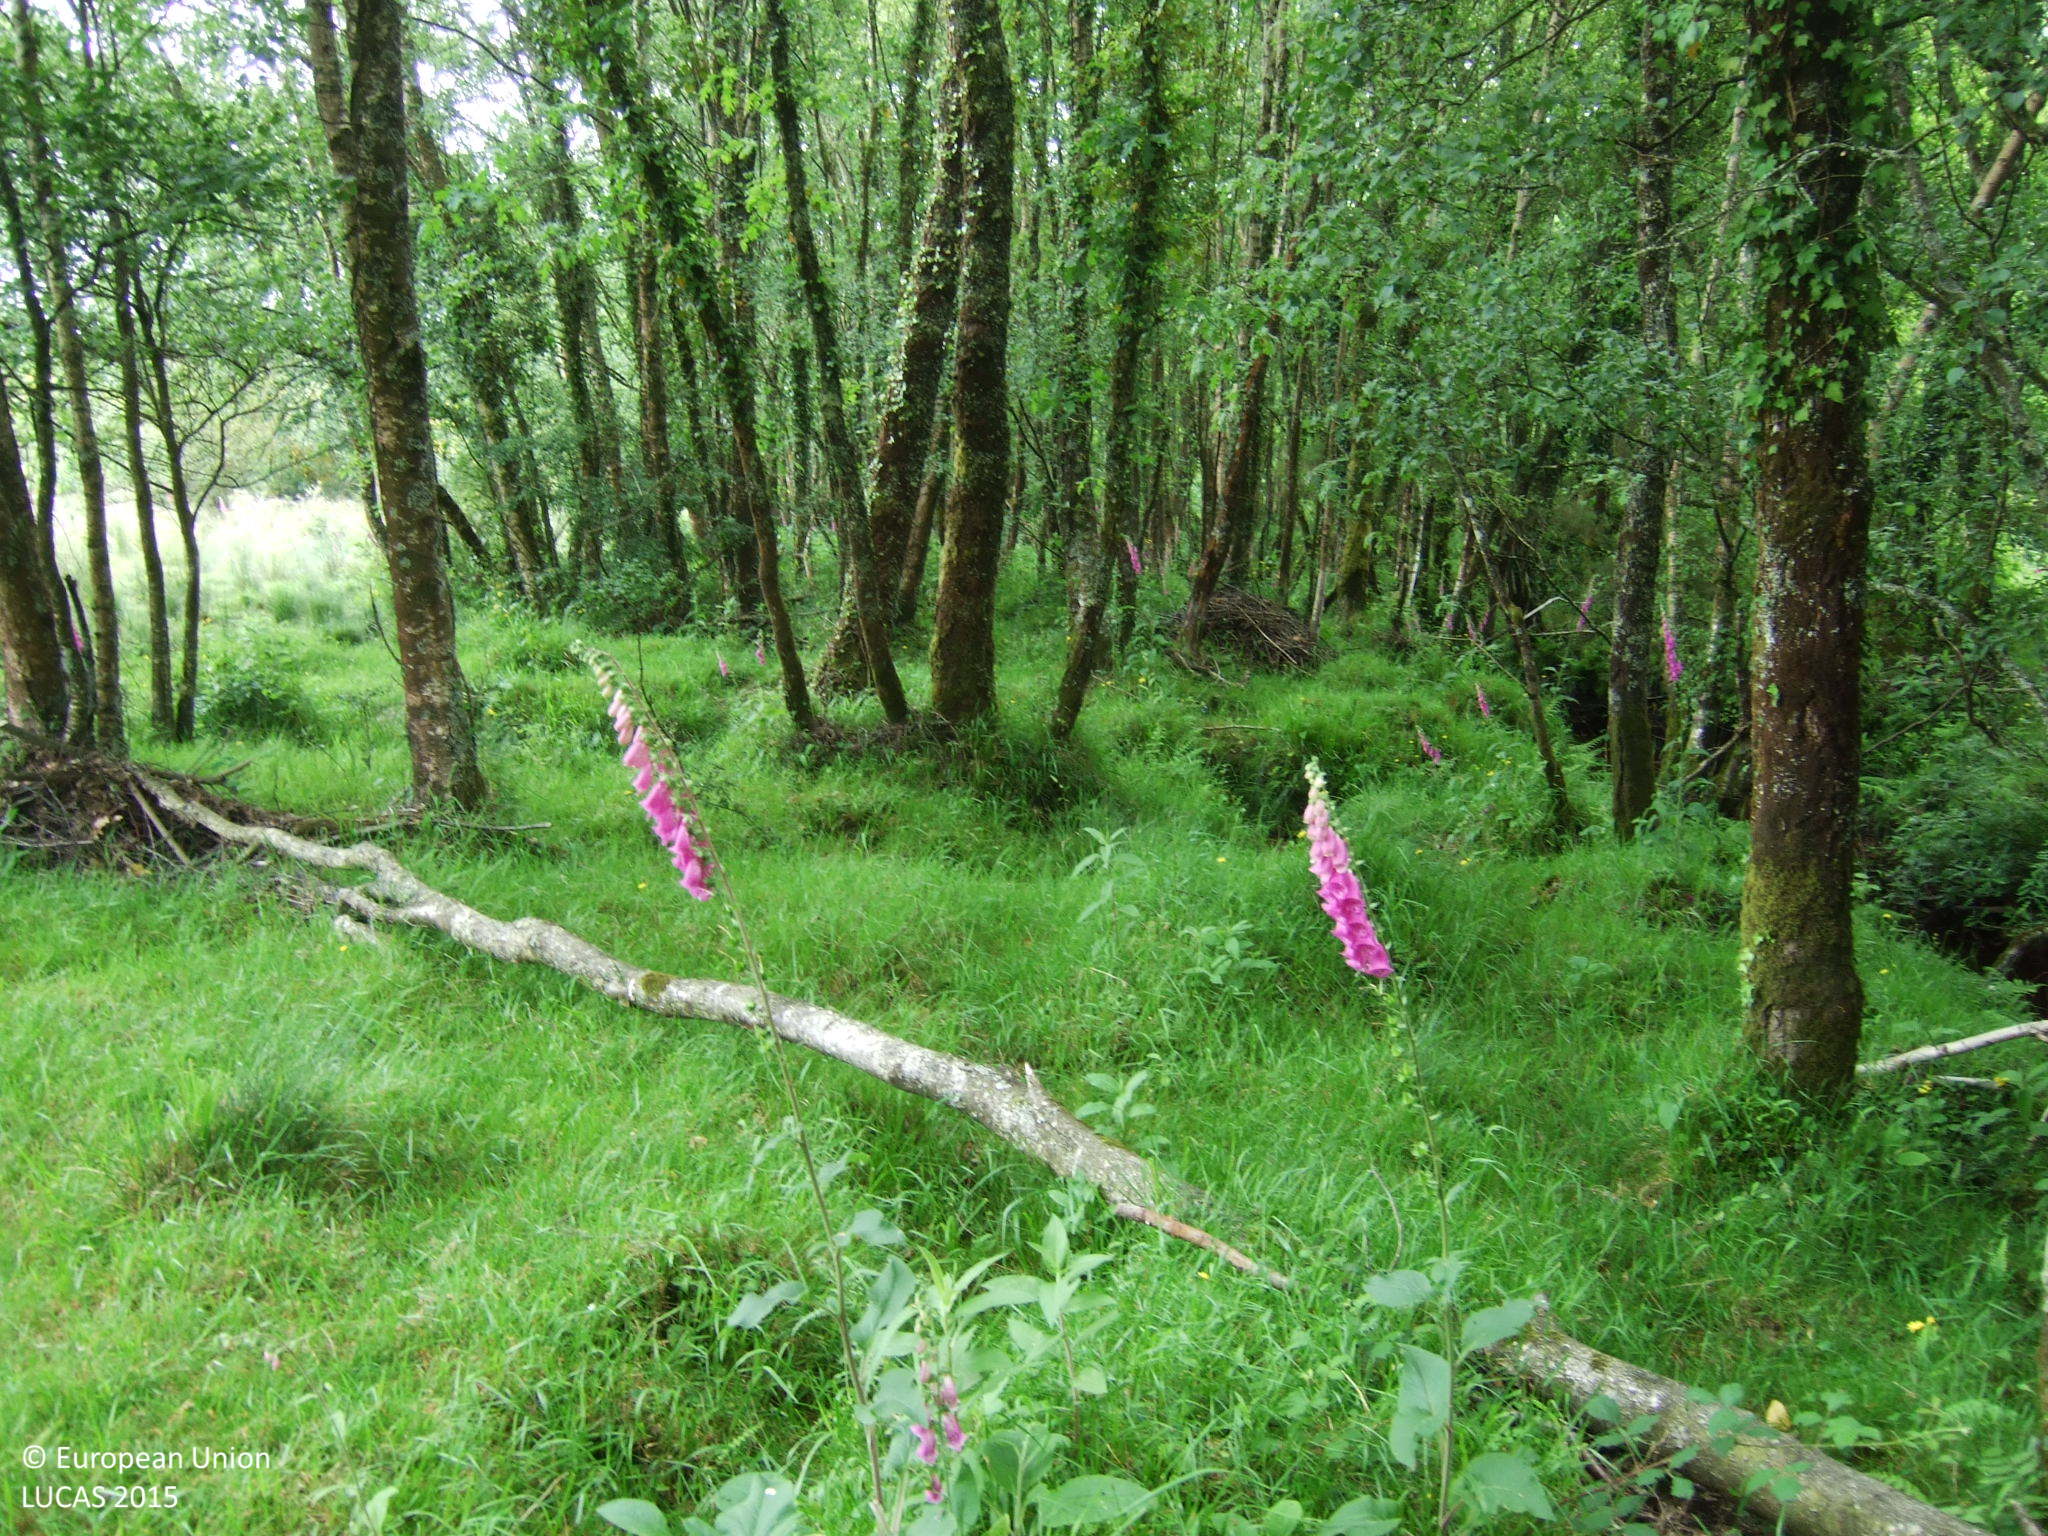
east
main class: Woodland
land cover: Broadleaved woodland
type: floodplain forest
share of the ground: 50 - 75 %
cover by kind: broadleaved forest trees 70 %, herbaceous plants 20 %, shrubs 10 %
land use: Semi-natural and natural areas not in use
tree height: > 5 m
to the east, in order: Broadleaved woodland; Inland fresh running water; Broadleaved woodland; Fences; Grassland without tree/shrub cover; Broadleaved woodland; Shrubland without tree cover; Electric lines; Shrubland without tree cover
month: June
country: ES
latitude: 43.4033
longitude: -7.8083
